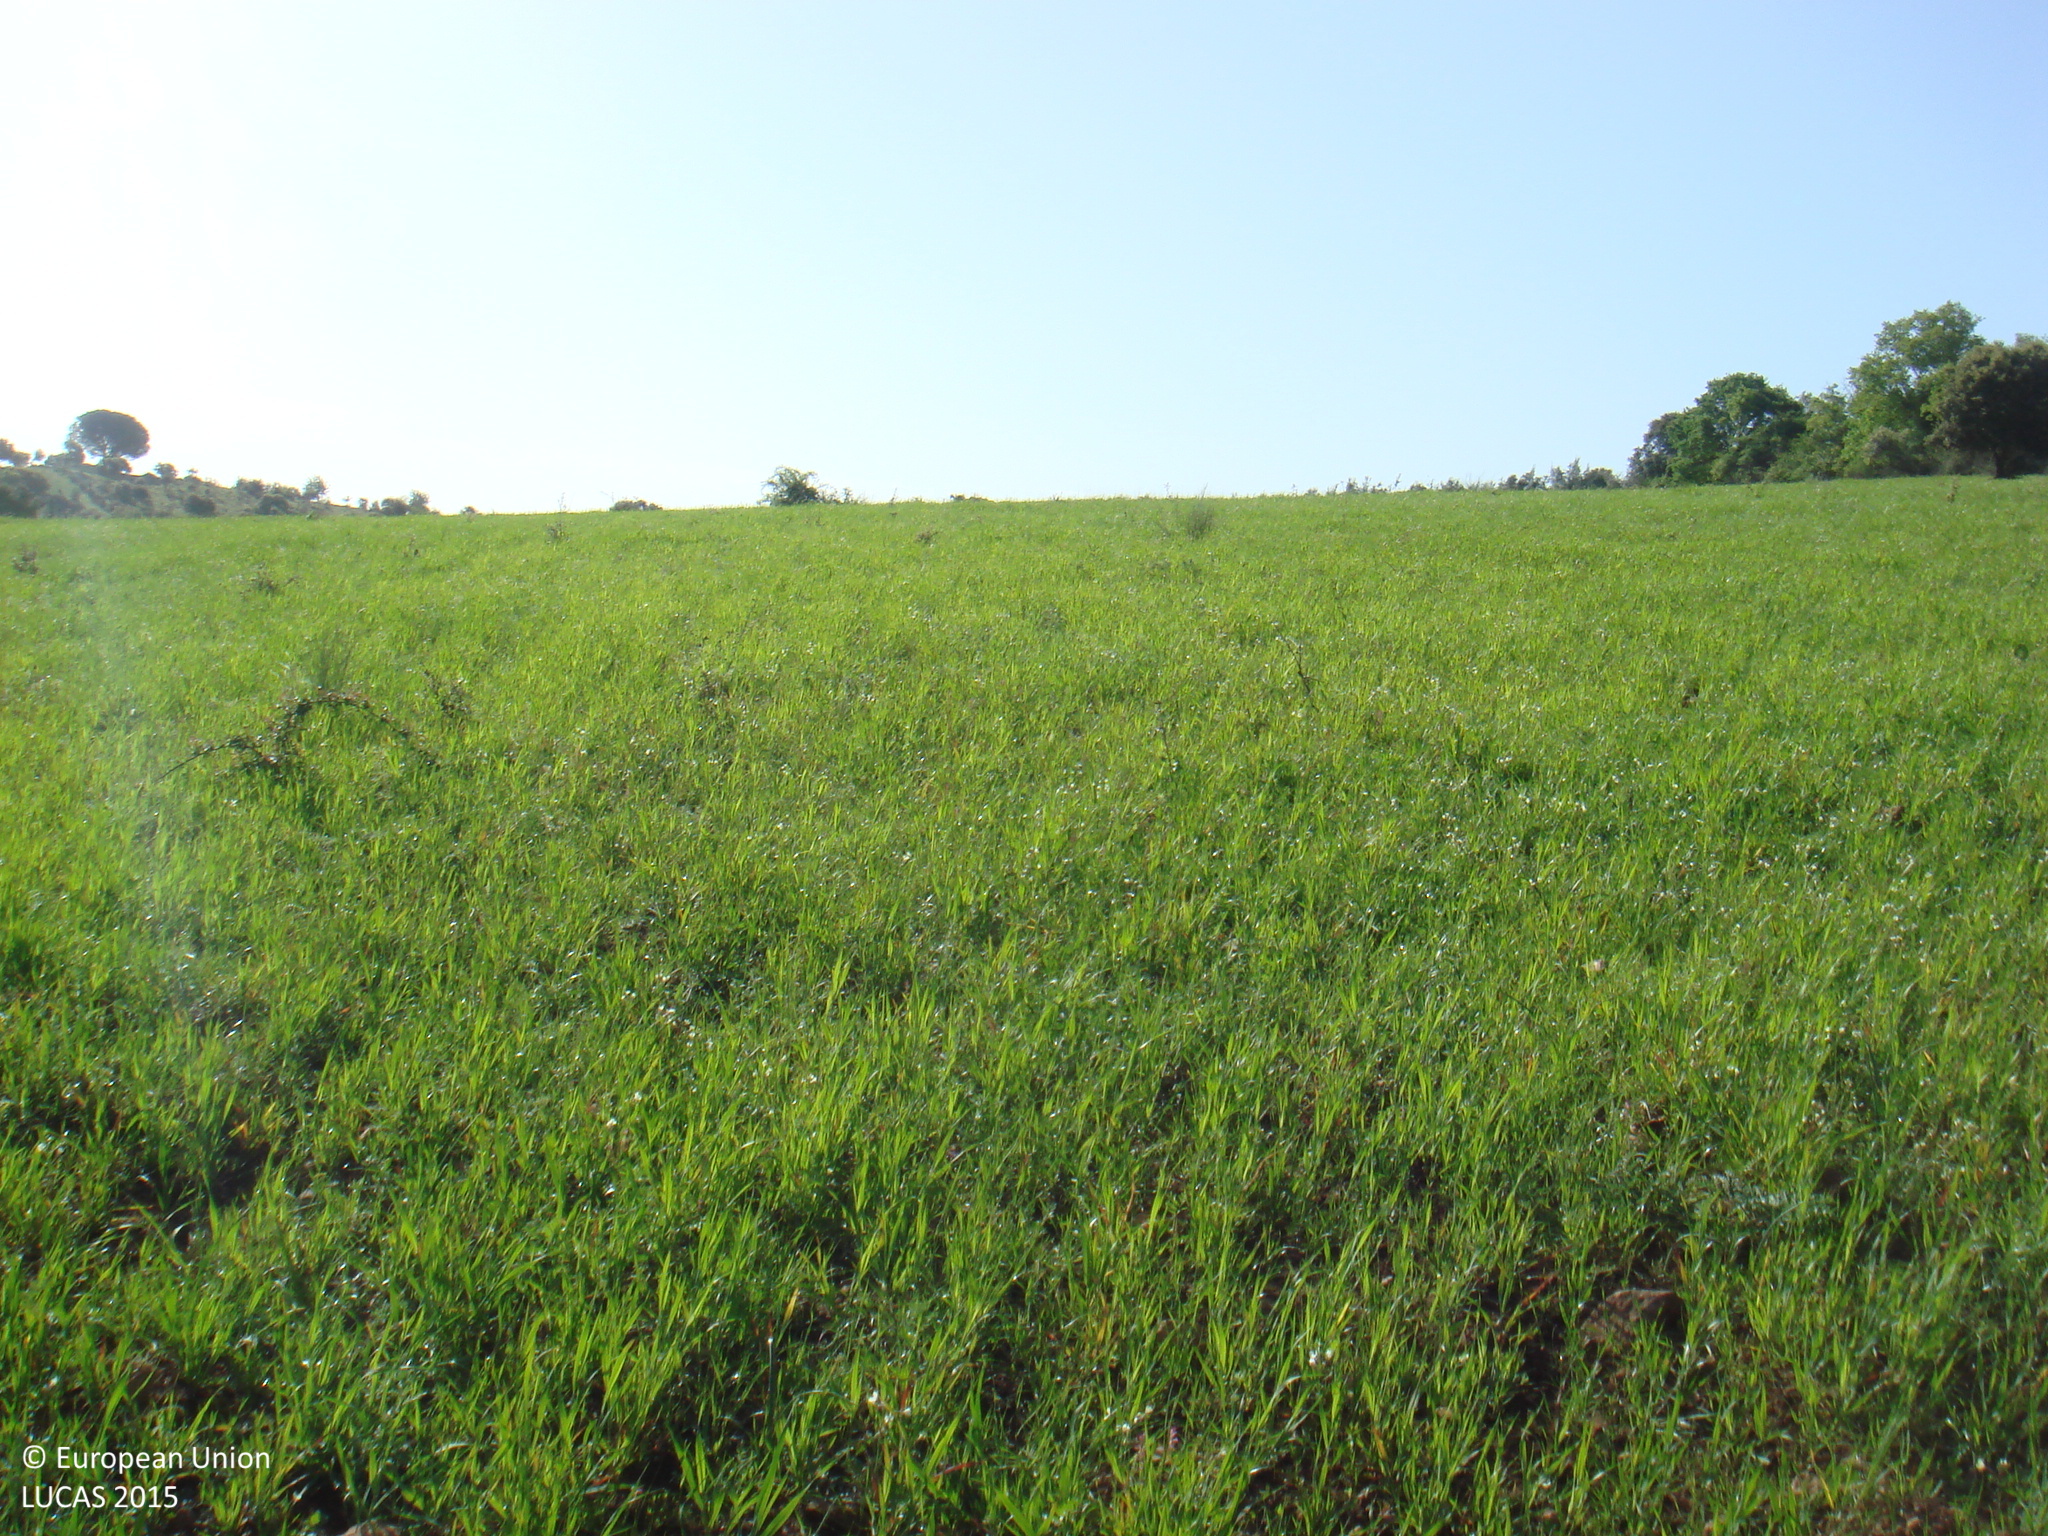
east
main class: Cropland
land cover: Oats
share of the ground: > 75 %
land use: Agriculture (excluding fallow land and kitchen gardens)
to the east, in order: Oats; Rivers and streams; Oats; Broadleaved woodland
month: April
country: ES
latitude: 38.1042
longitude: -5.0641
